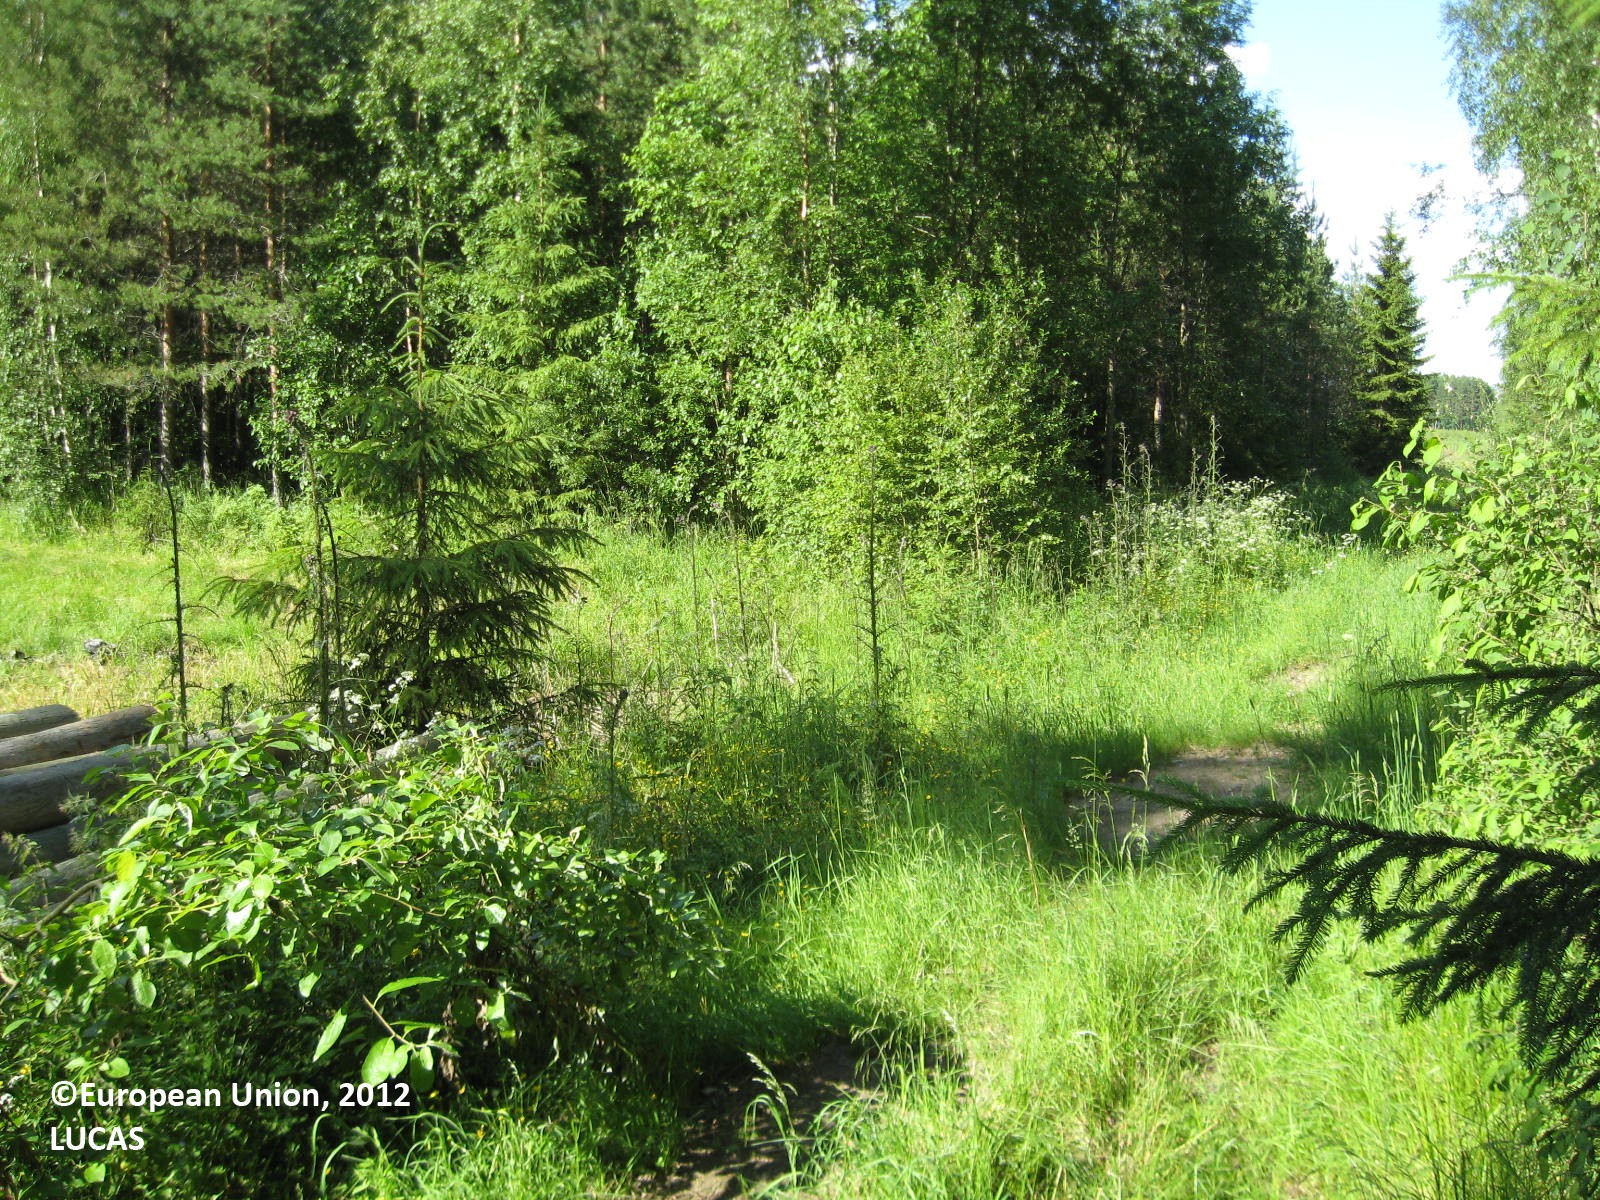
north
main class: Woodland
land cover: Pine dominated mixed woodland
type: boreal forest
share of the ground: > 75 %
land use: Forestry
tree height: > 5 m
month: July
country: FI
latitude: 62.5932
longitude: 22.8144
